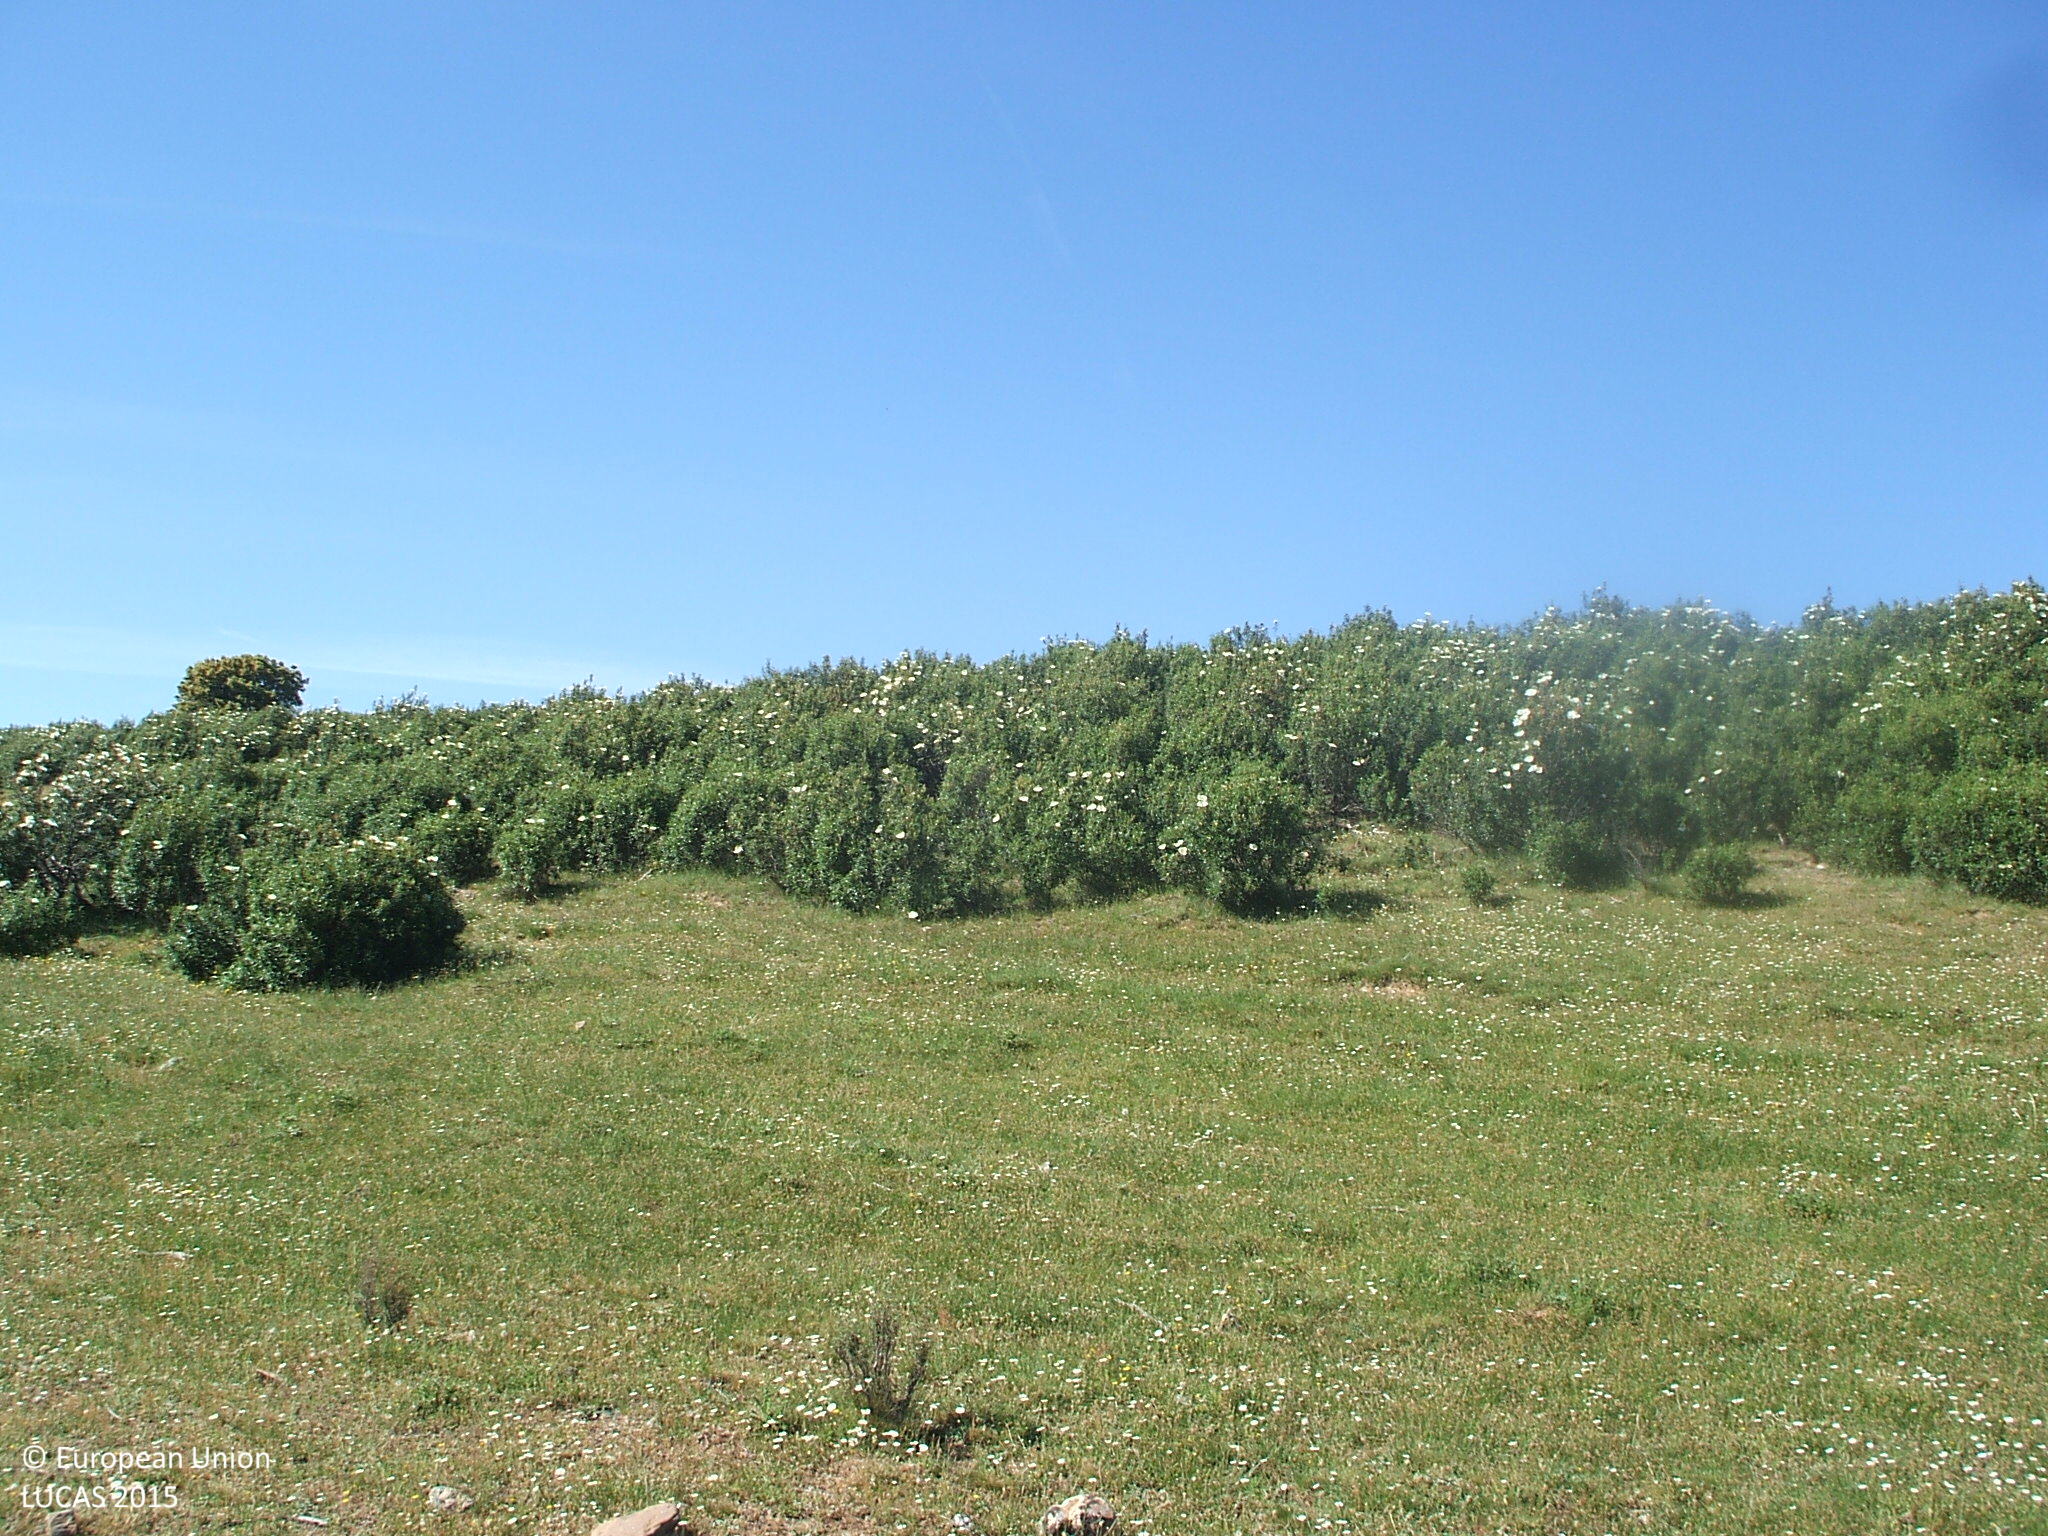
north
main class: Grassland
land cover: Grassland without tree/shrub cover
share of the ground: > 75 %
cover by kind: herbaceous plants 100 %
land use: Agriculture (excluding fallow land and kitchen gardens)
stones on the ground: > 50 %
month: May
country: ES
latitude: 41.0752
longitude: -3.0461
